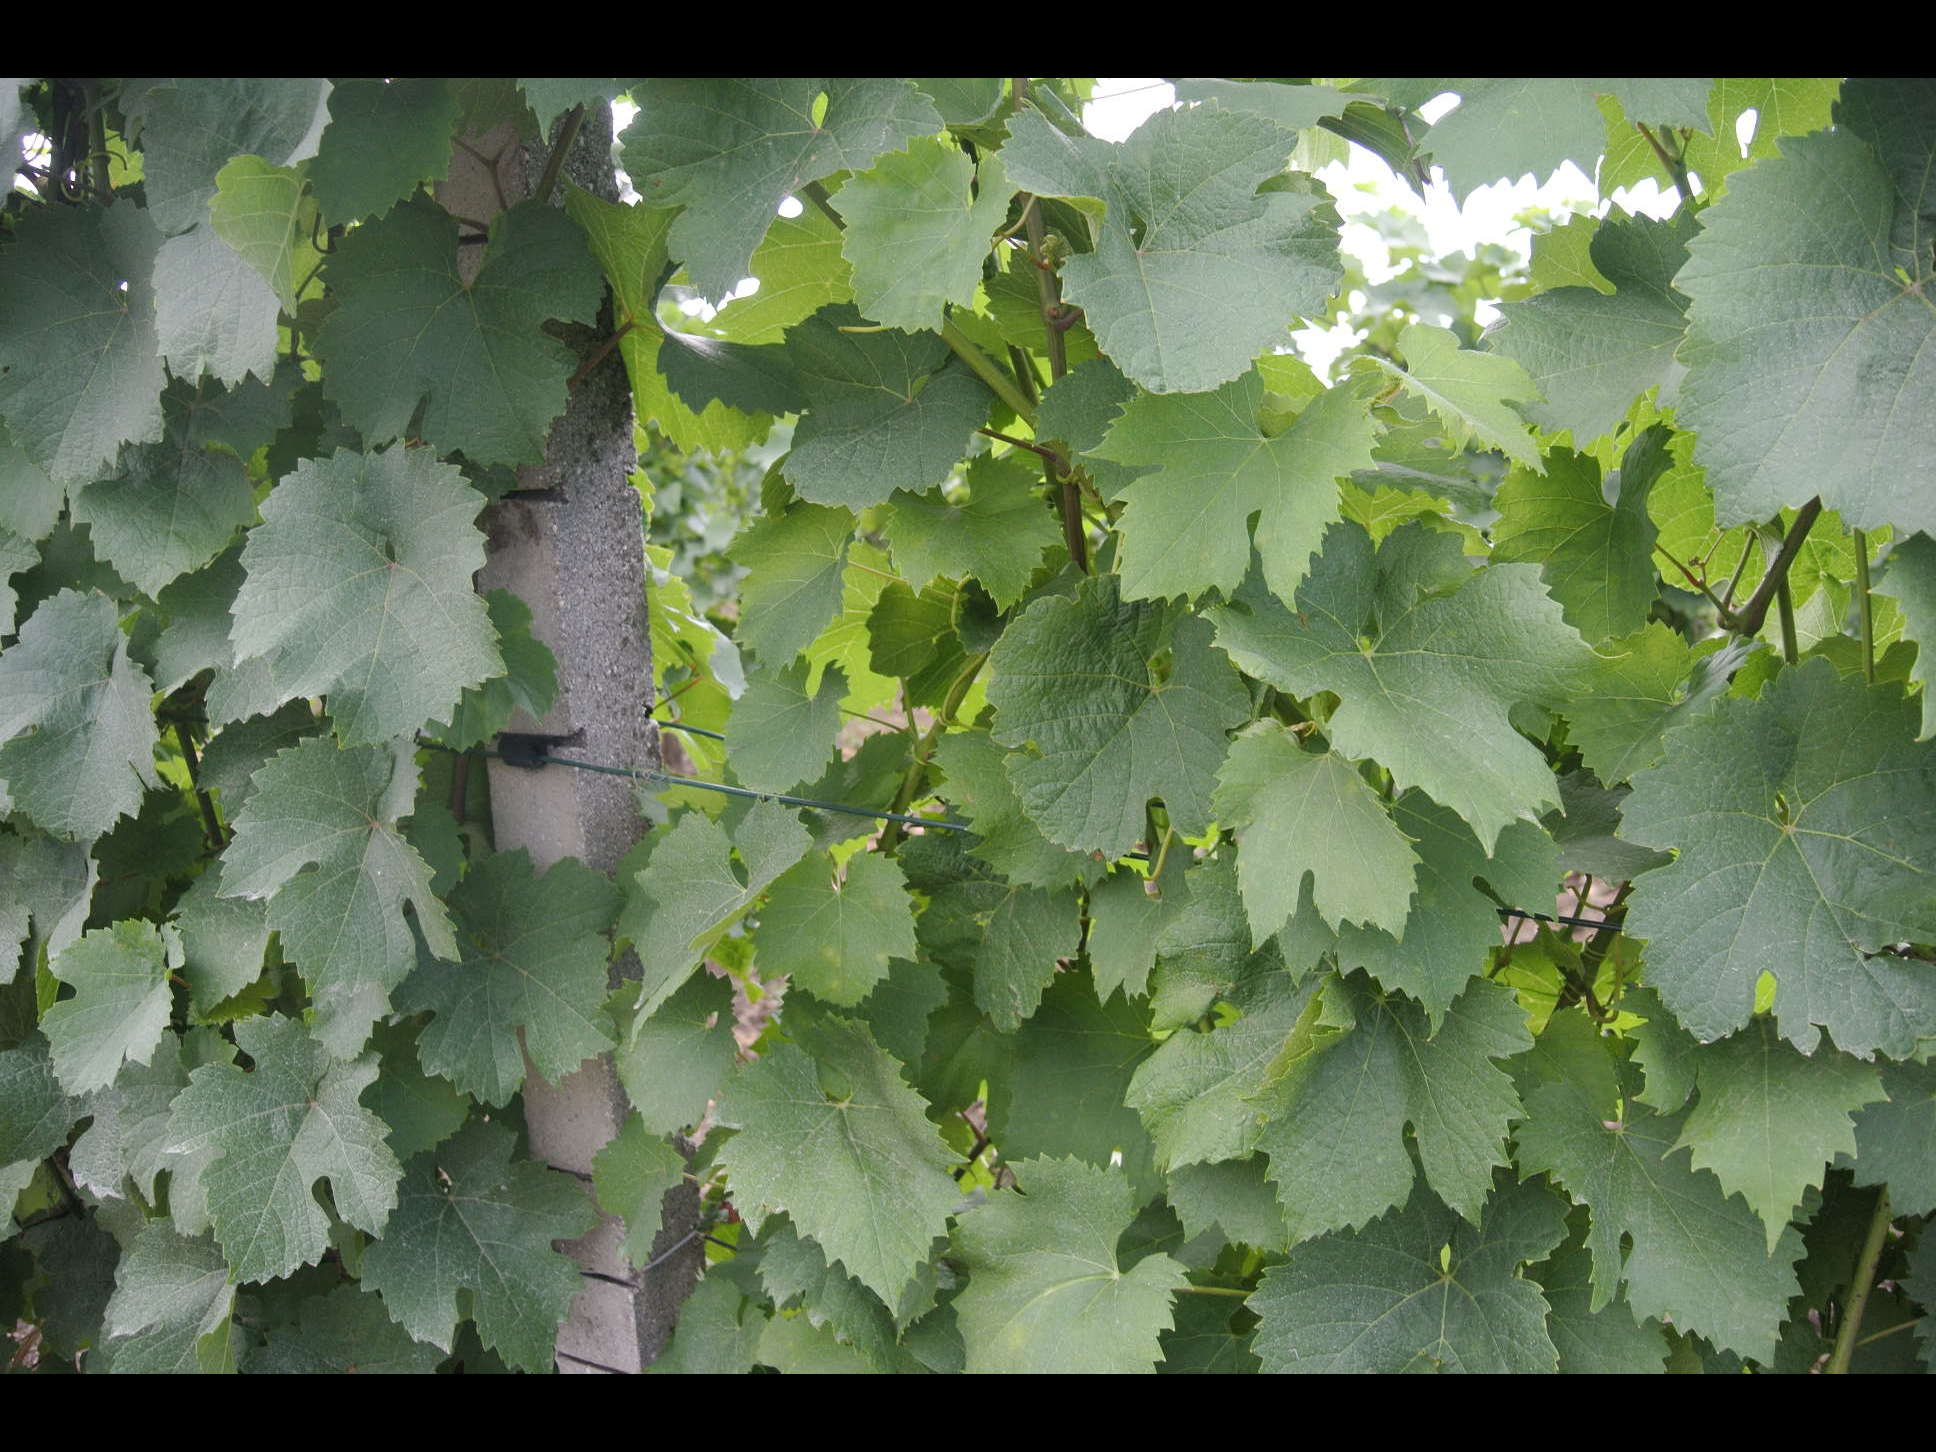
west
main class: Cropland
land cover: Vineyards
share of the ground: 25 - 50 %
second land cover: Other bare soil
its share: > 75 %
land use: Agriculture (excluding fallow land and kitchen gardens)
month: July
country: AT
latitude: 47.8975
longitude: 16.9220
